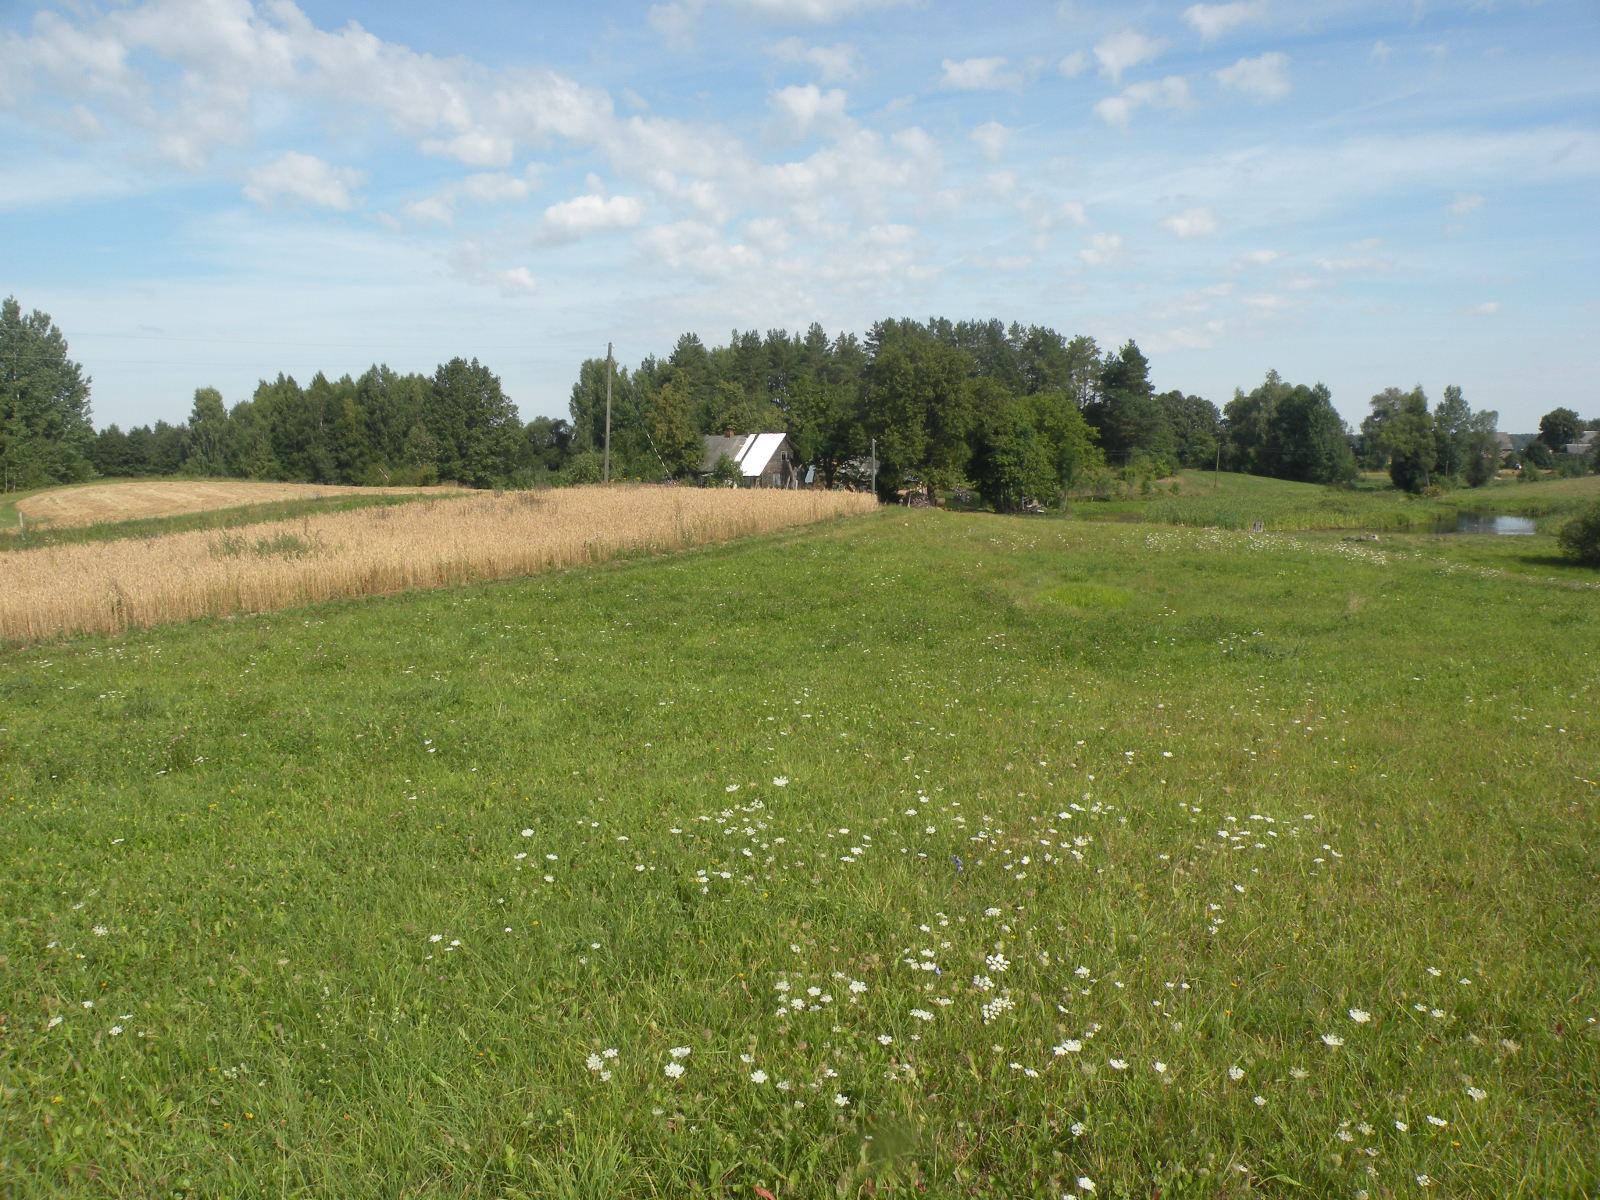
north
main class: Grassland
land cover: Grassland without tree/shrub cover
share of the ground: > 75 %
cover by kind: herbaceous plants 100 %
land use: Agriculture (excluding fallow land and kitchen gardens)
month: August
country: LV
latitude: 55.9132
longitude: 26.2542
